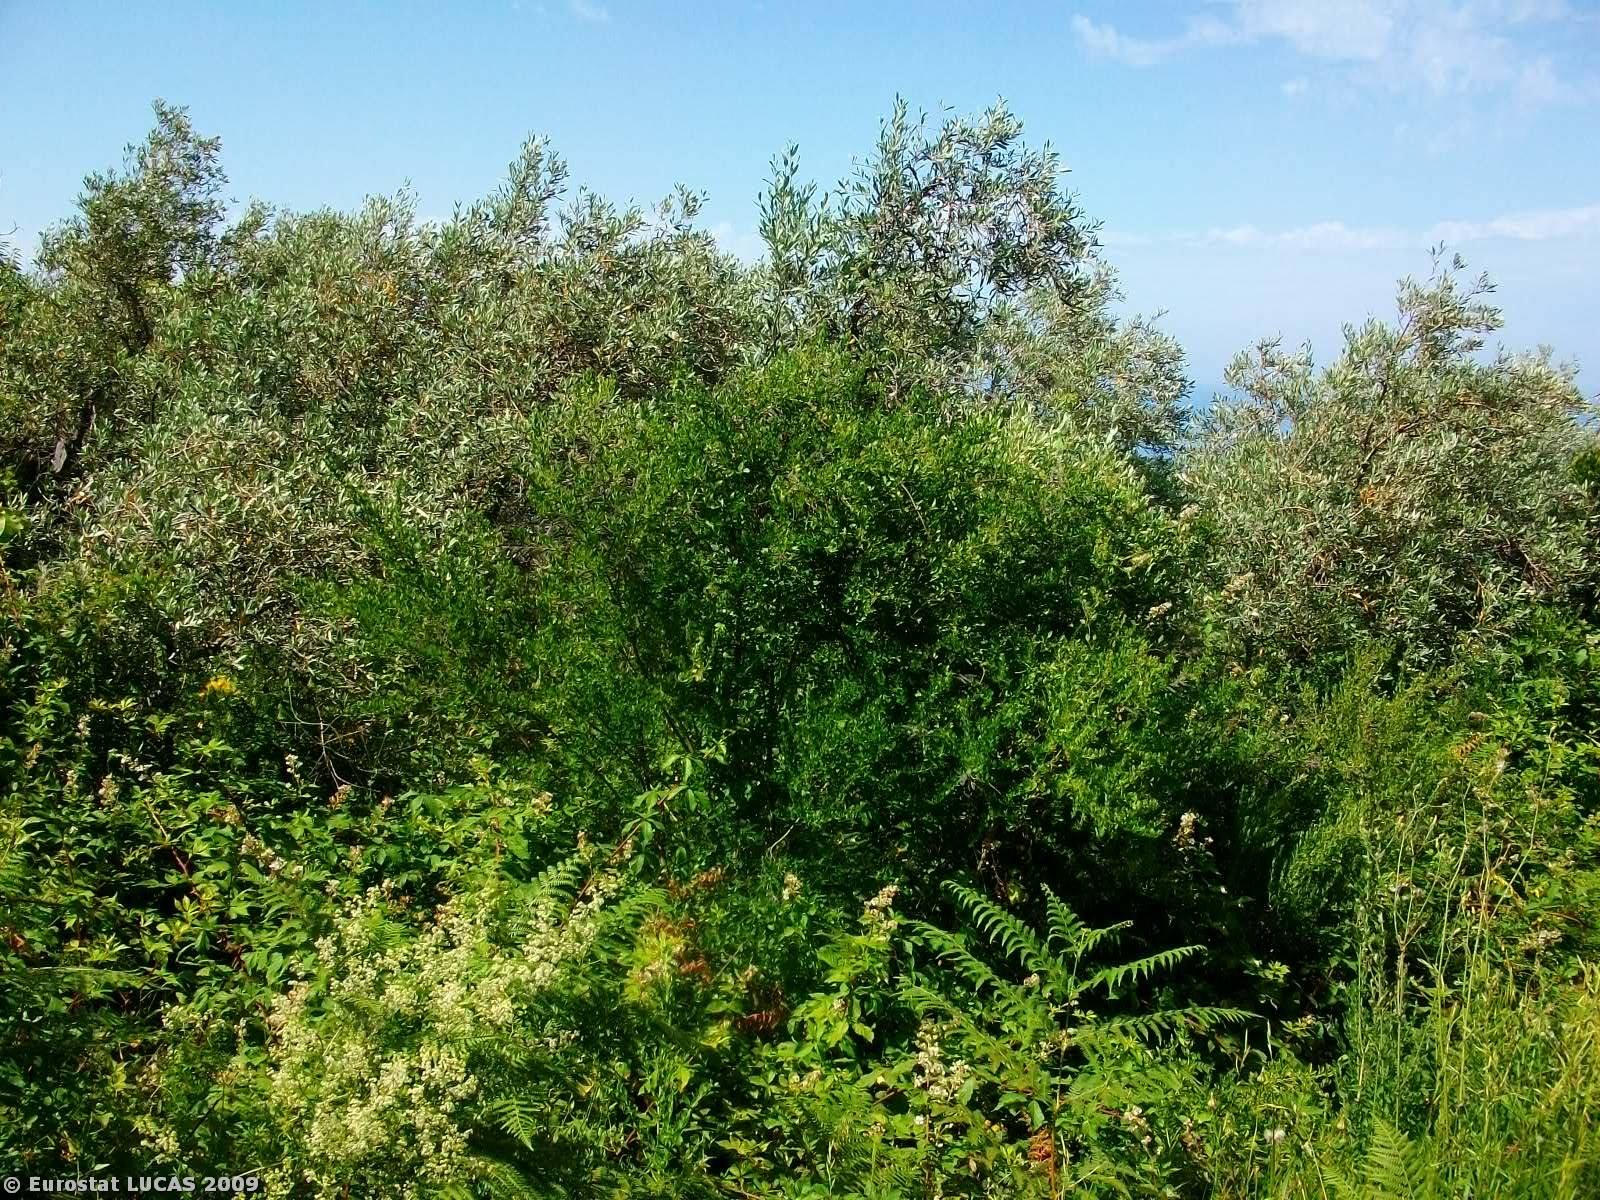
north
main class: Shrubland
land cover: Shrubland with sparse tree cover
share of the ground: > 75 %
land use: Nature reserves
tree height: < 5 m
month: June
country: GR
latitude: 39.3513
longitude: 23.2114
